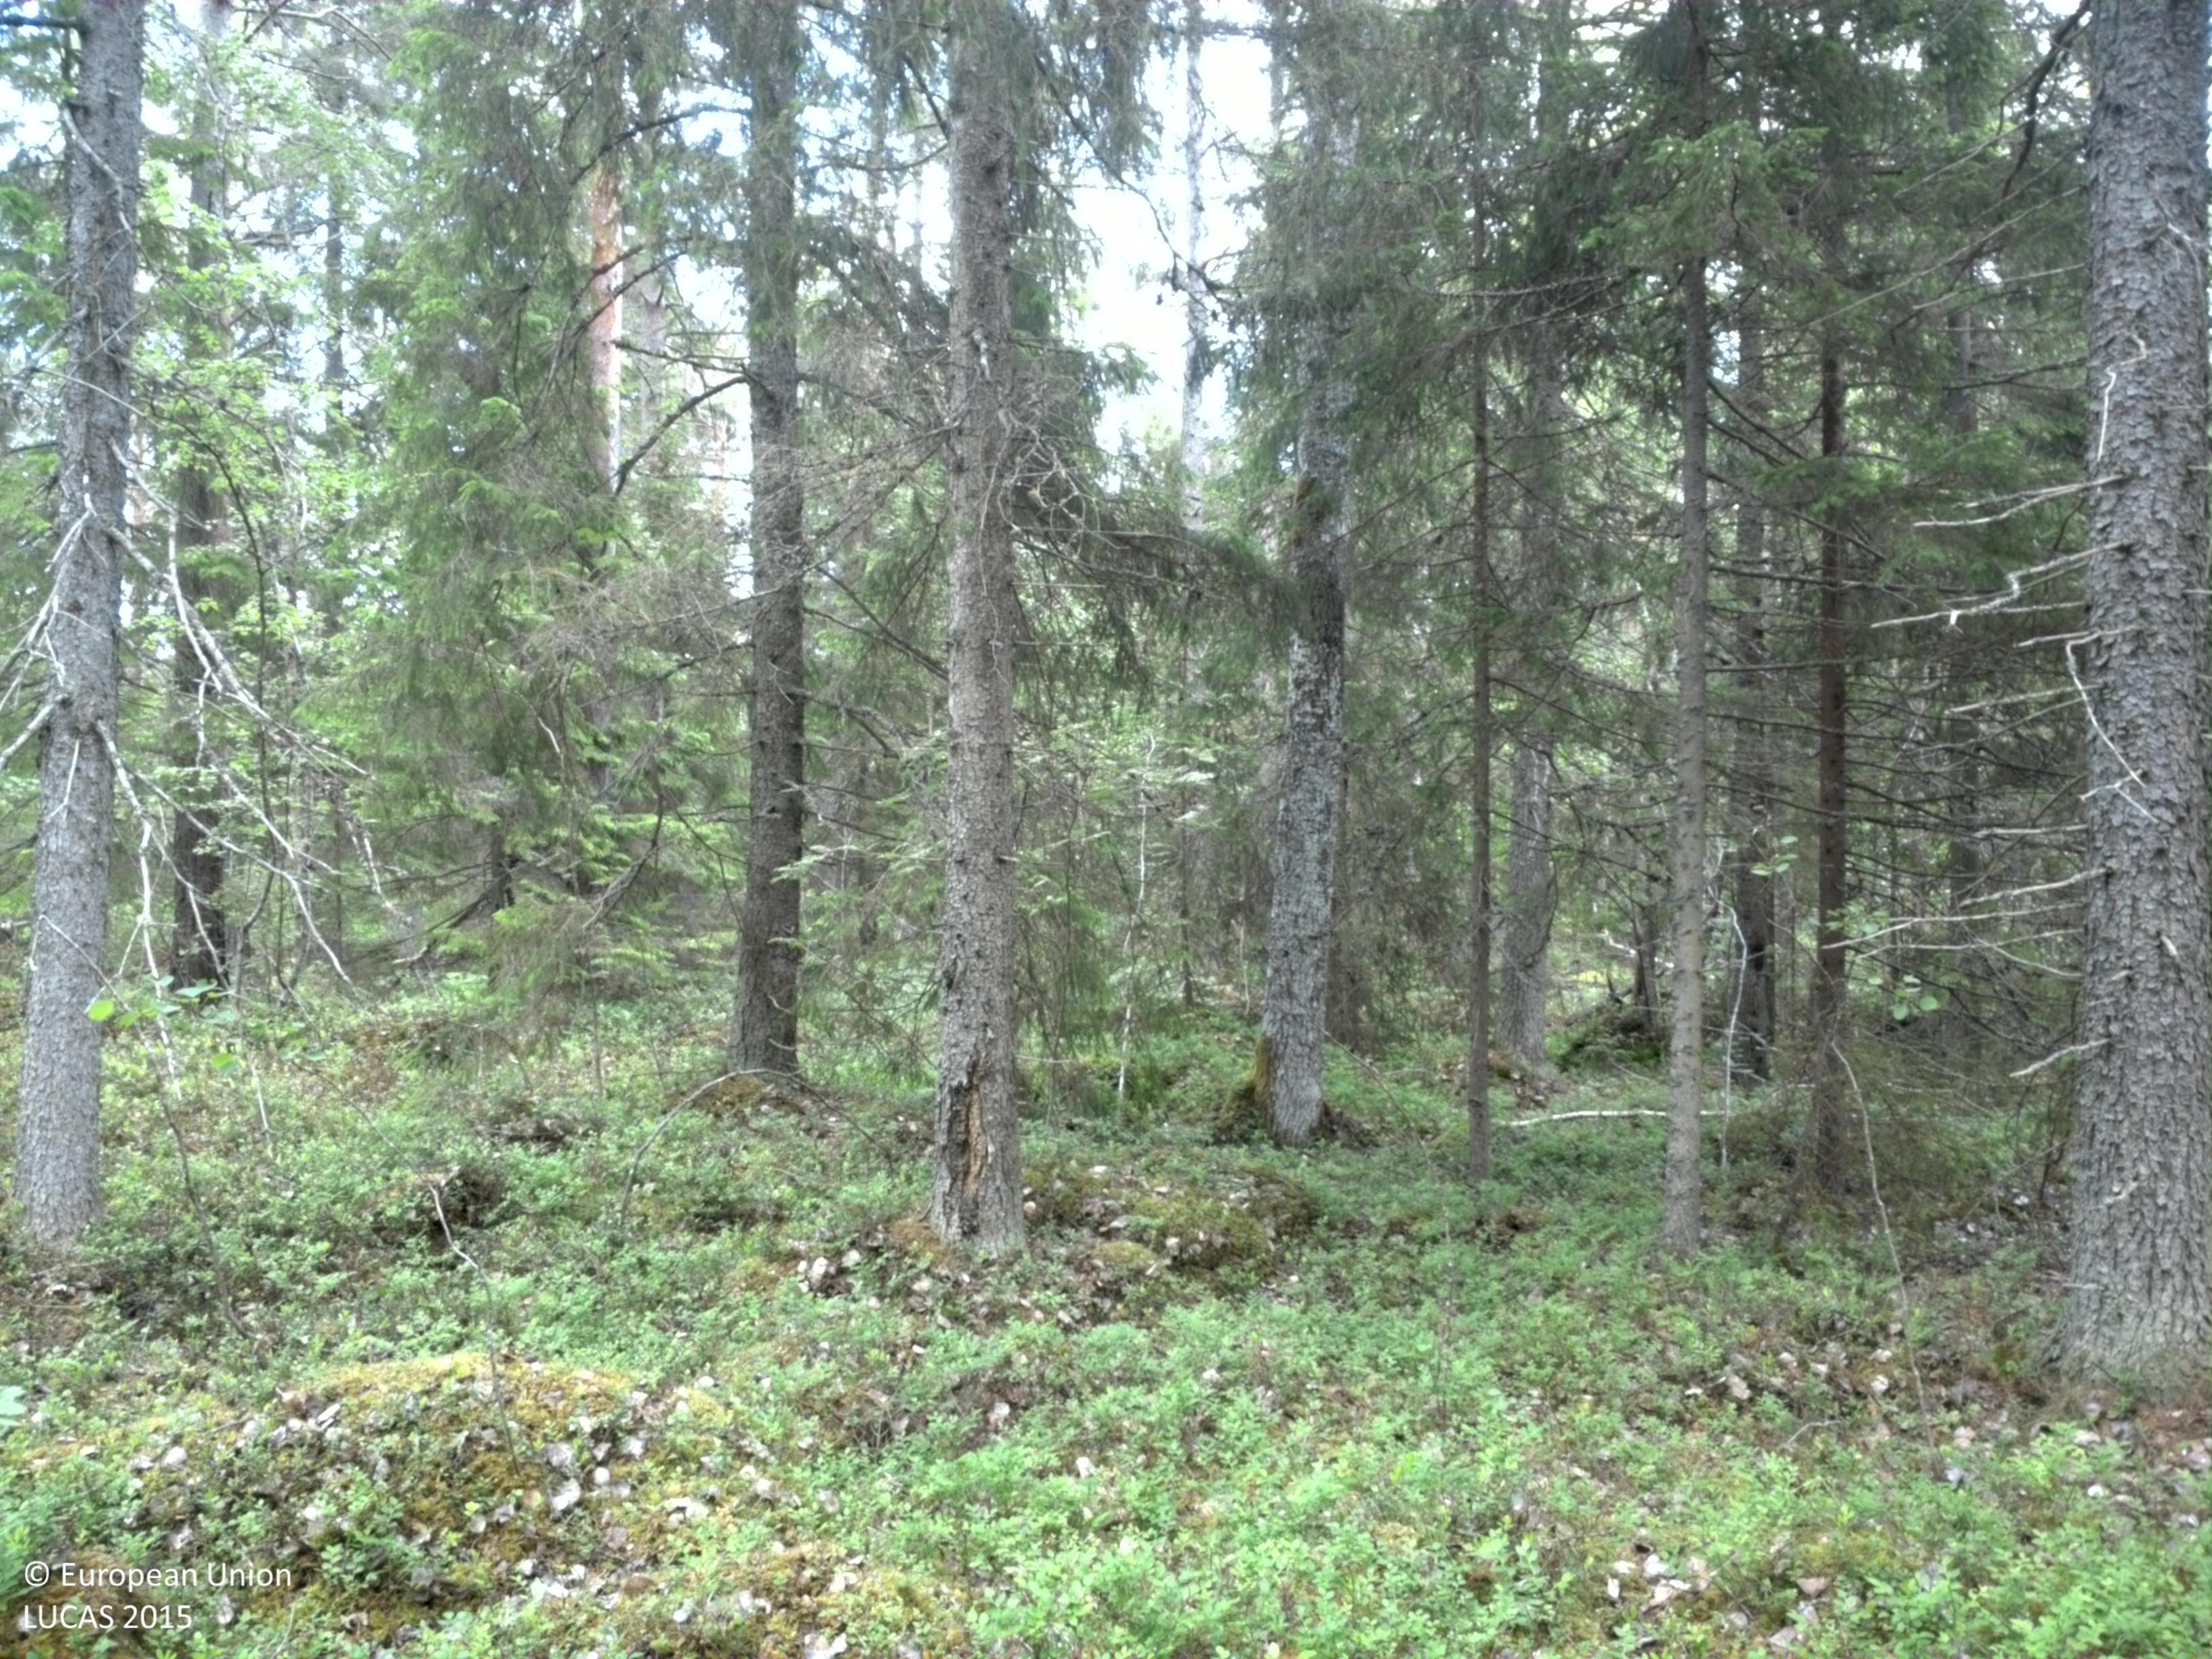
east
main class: Woodland
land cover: Spruce dominated coniferous woodland
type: boreal forest
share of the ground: 50 - 75 %
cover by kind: coniferous forest trees 55 %, herbaceous plants 20 %, lichens and mosses 20 %, broadleaved forest trees 5 %
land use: Forestry
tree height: > 5 m
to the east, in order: Spruce dominated coniferous woodland; Pine dominated coniferous woodland; Pine dominated mixed woodland; Pine dominated coniferous woodland
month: June
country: SE
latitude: 60.0939
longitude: 18.6831
